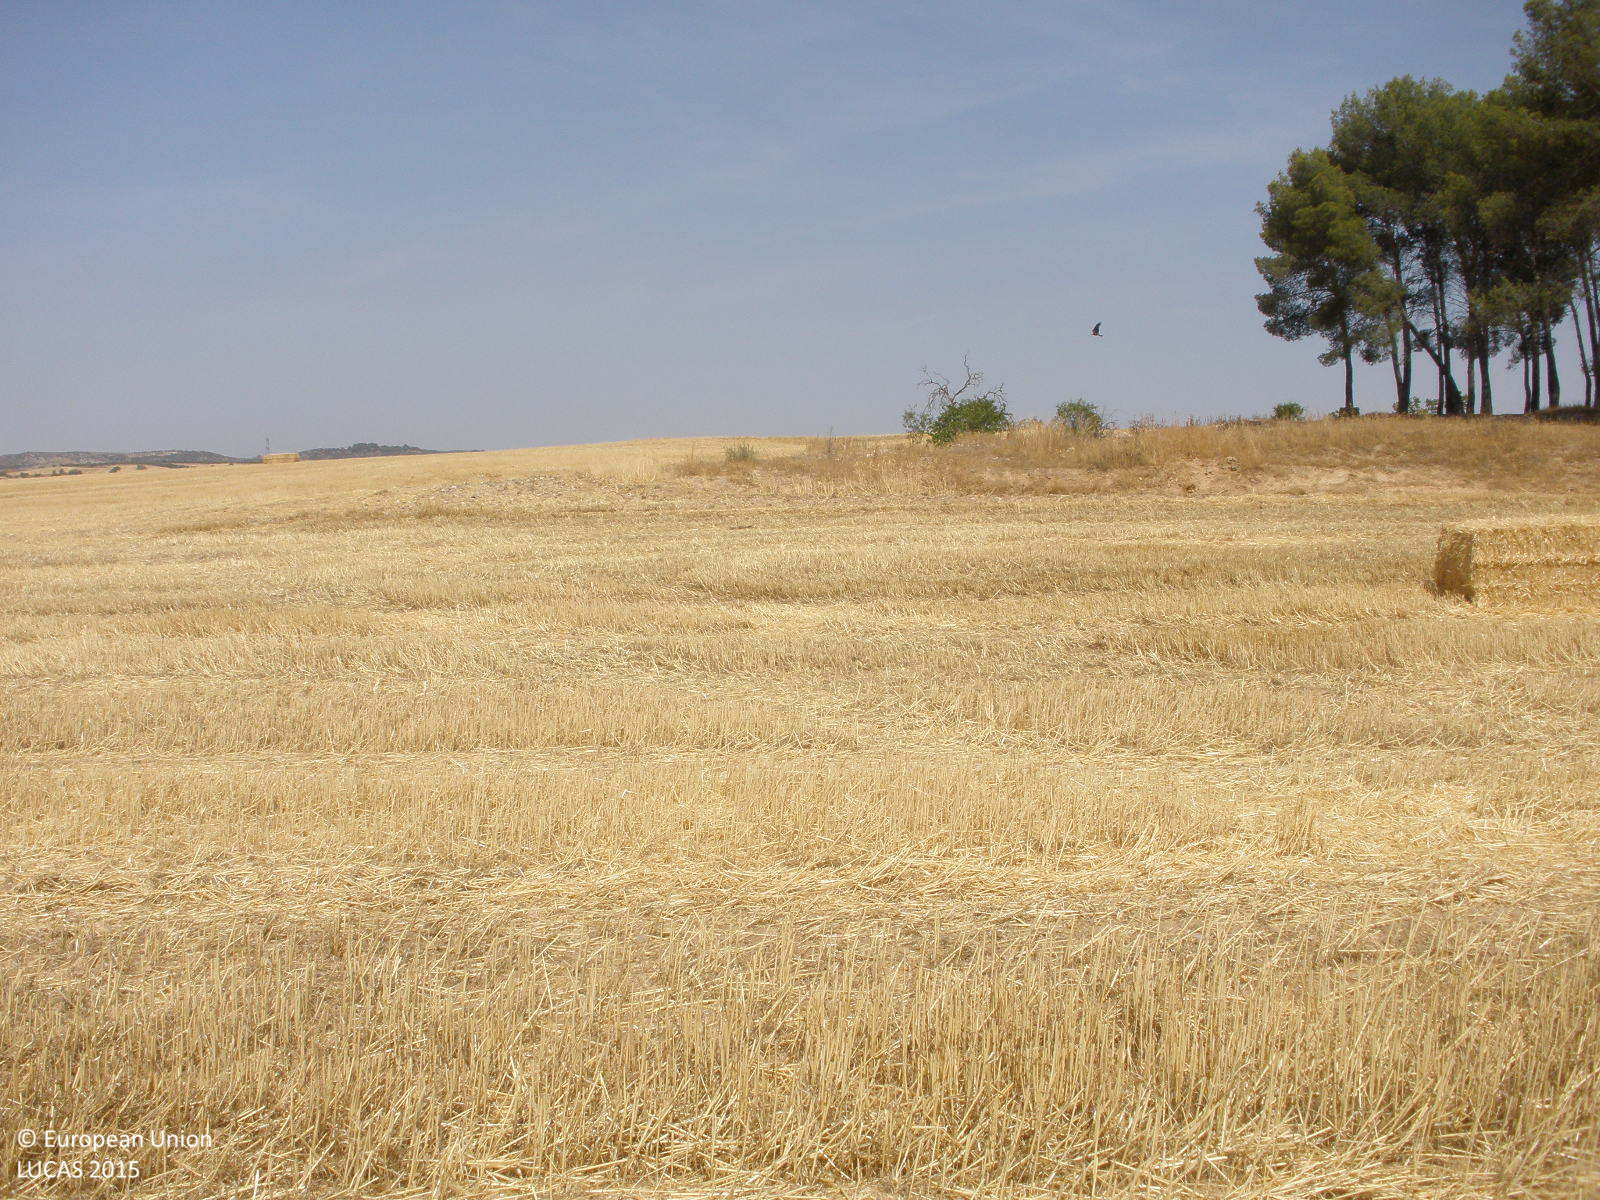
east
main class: Cropland
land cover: Common wheat
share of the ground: < 10 %
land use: Agriculture (excluding fallow land and kitchen gardens)
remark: Harvested field
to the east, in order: Common wheat; Shrubland without tree cover; Common wheat; Lines of trees; Grass margins; Tracks; Grass margins; Lines of trees; Other bare soil
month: July
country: ES
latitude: 40.3415
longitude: -3.4655
